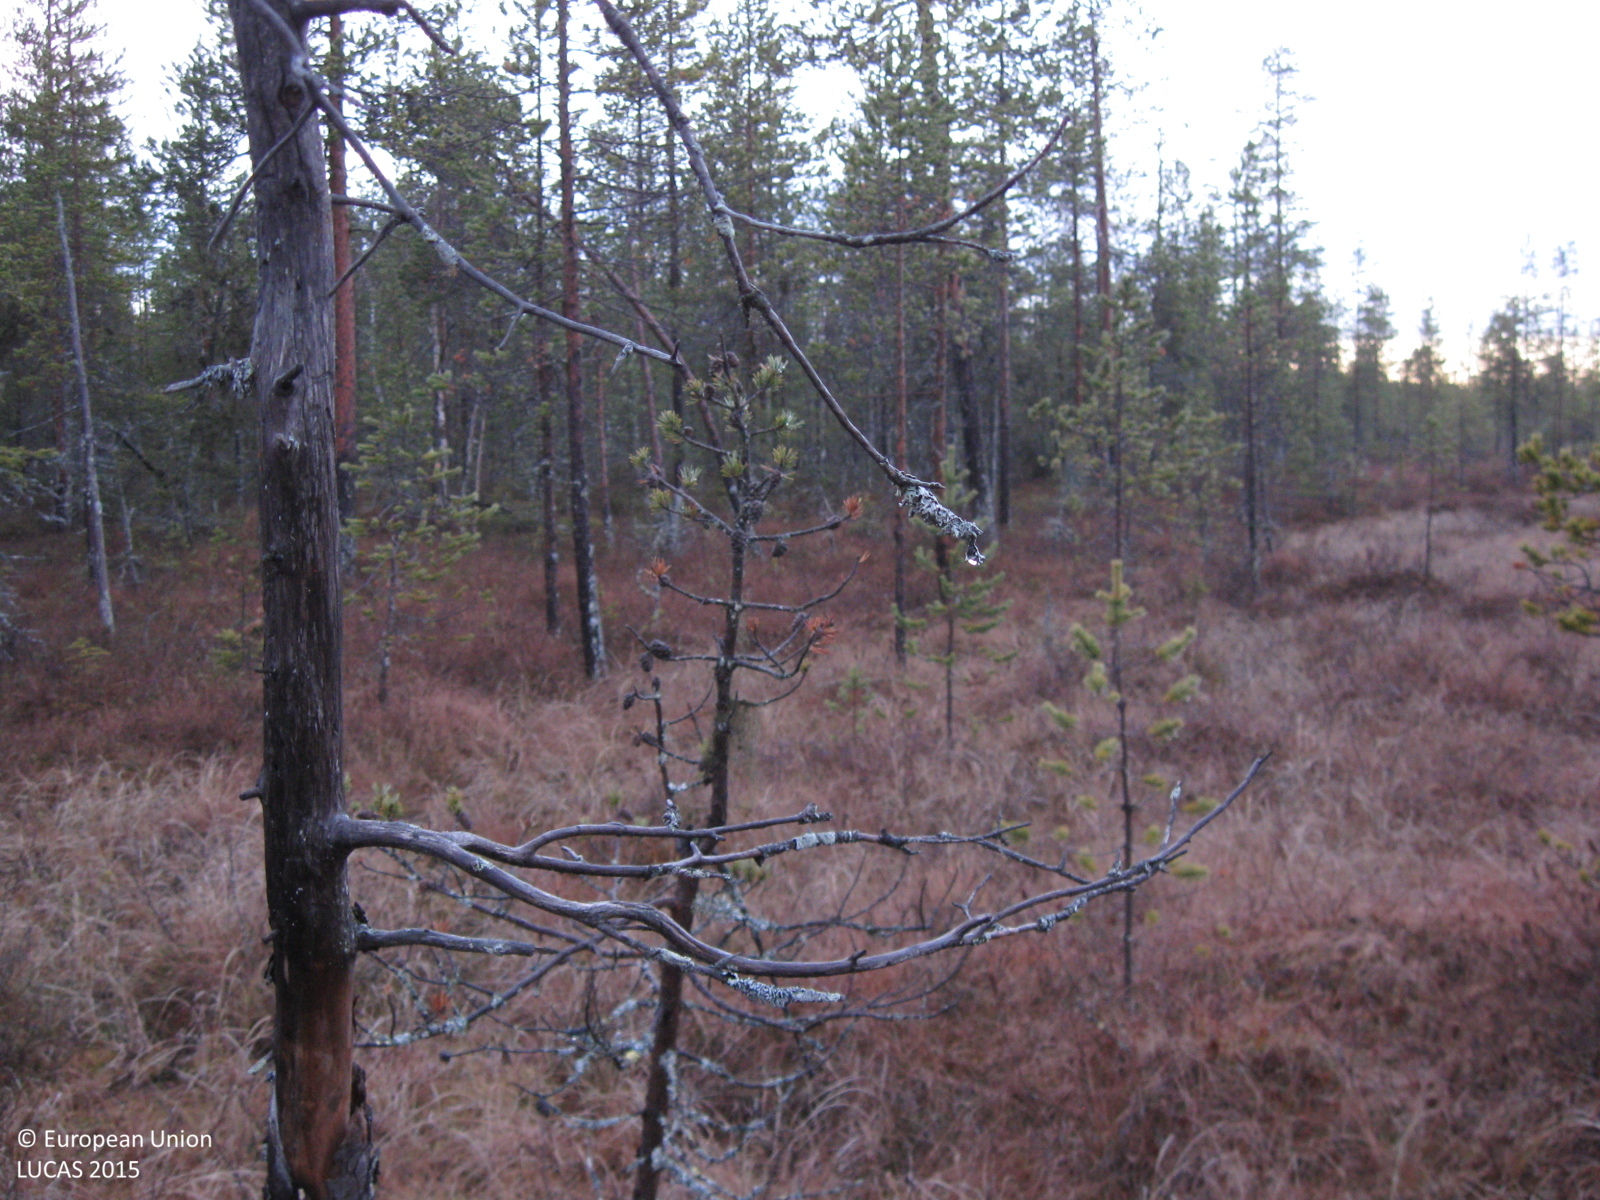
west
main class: Woodland
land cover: Pine dominated coniferous woodland
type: mire and swamp forests
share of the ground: 25 - 50 %
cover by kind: shrubs 40 %, coniferous forest trees 35 %, herbaceous plants 15 %, lichens and mosses 10 %
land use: Semi-natural and natural areas not in use
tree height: < 5 m
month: October
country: SE
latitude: 66.4341
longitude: 20.9201
